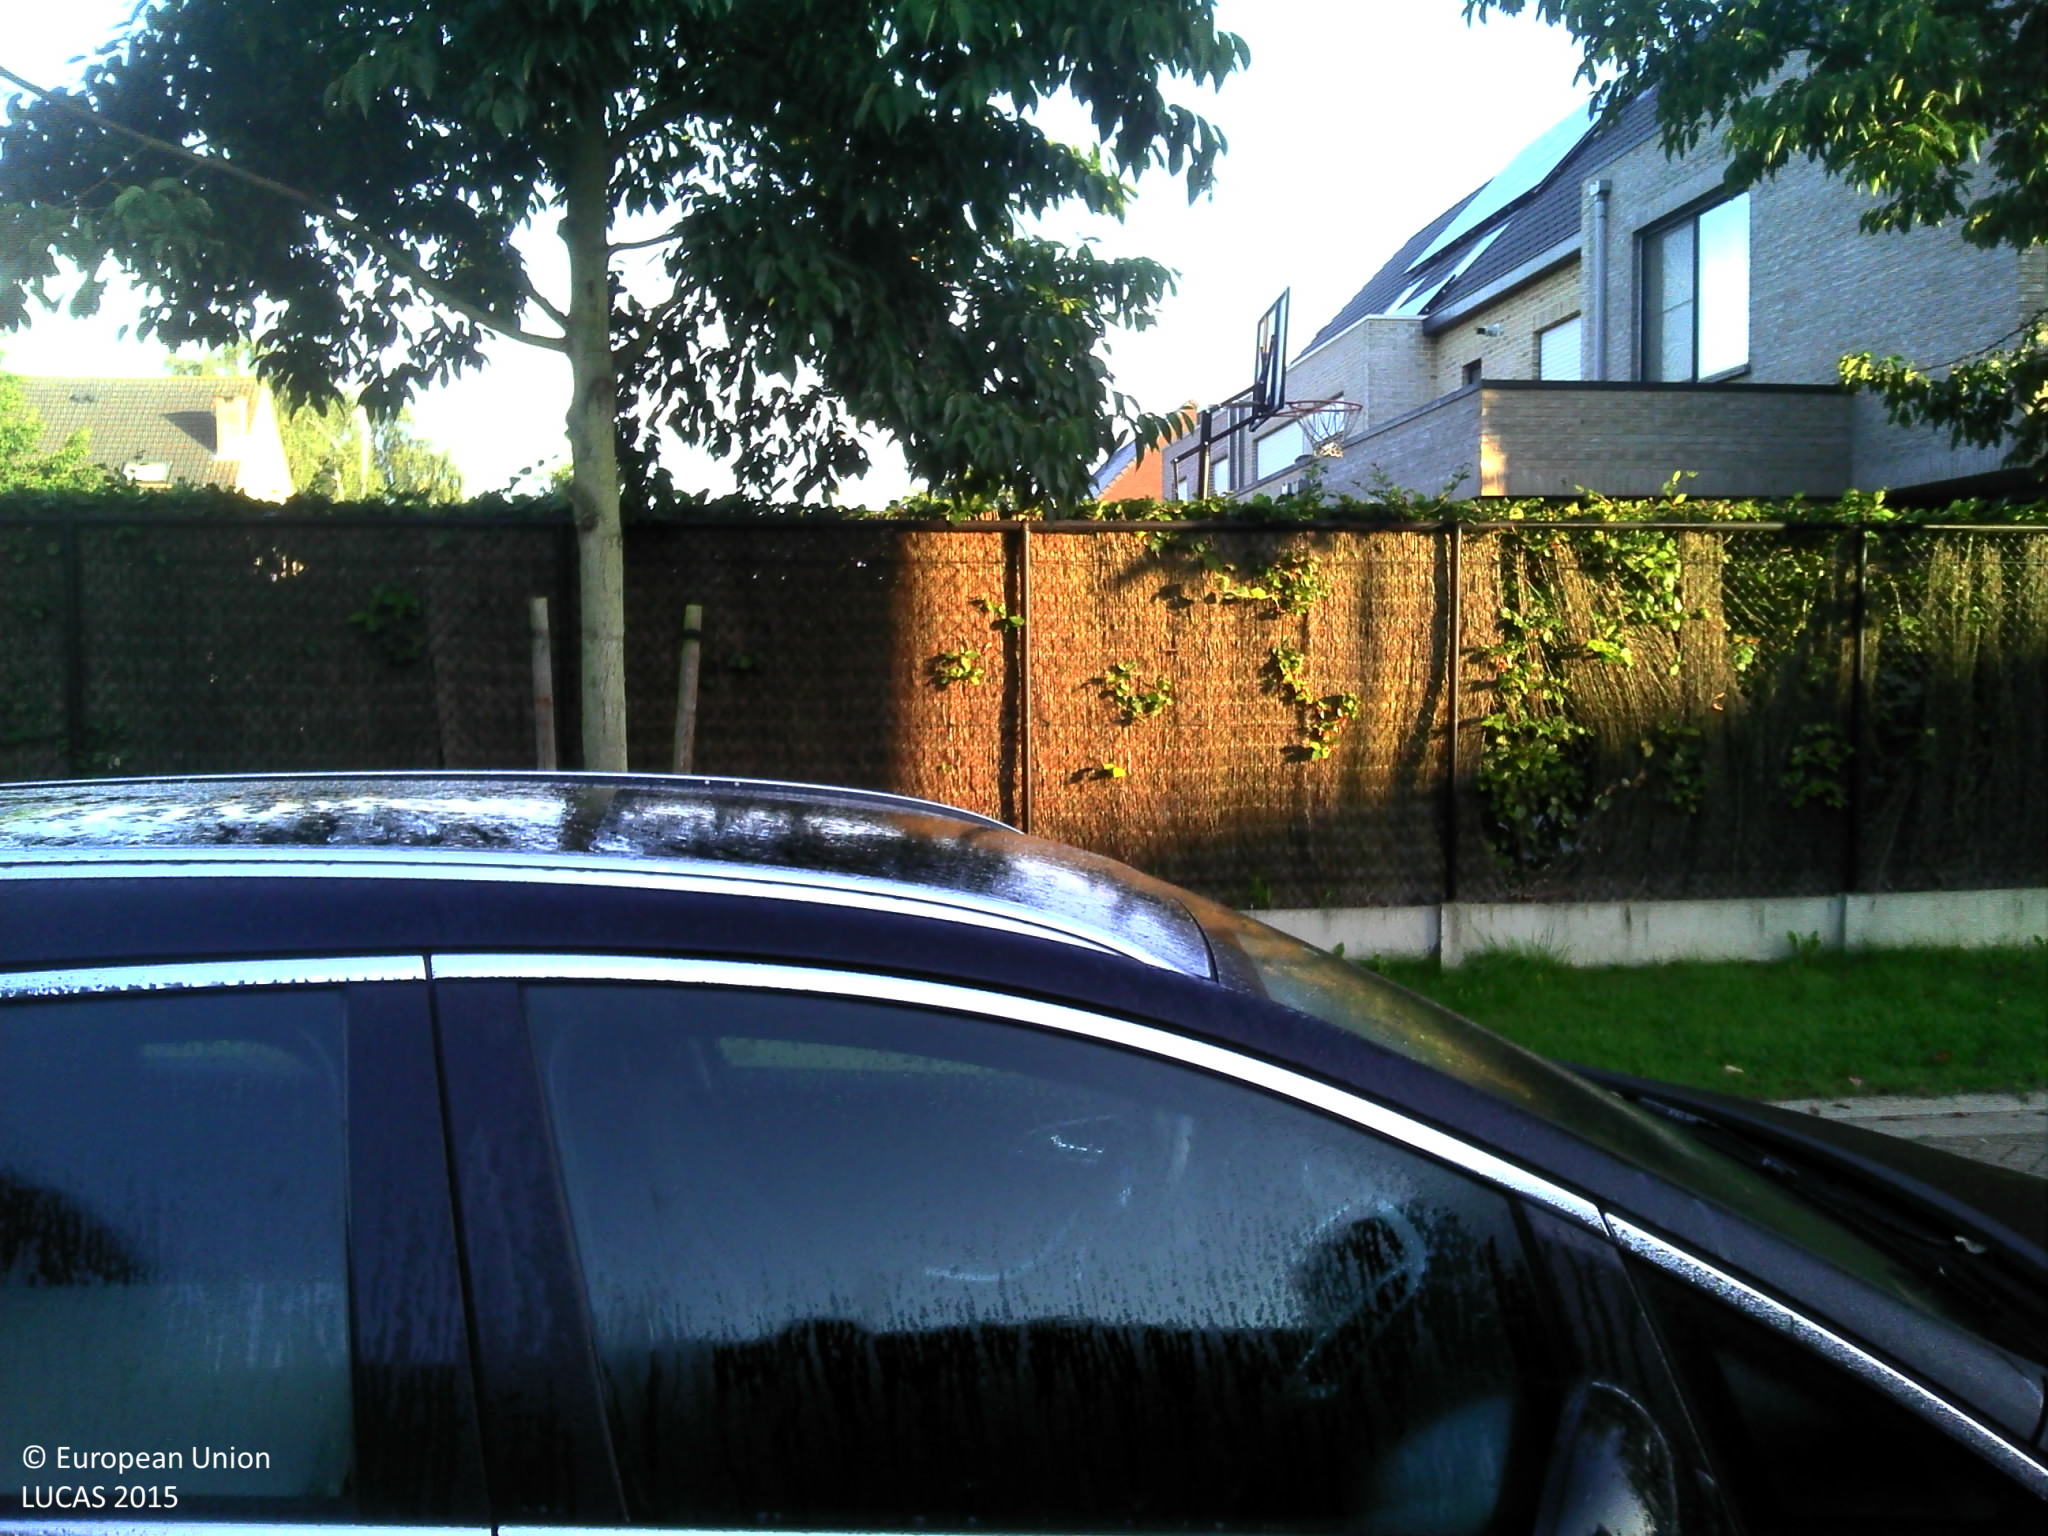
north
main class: Grassland
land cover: Grassland without tree/shrub cover
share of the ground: > 75 %
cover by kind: herbaceous plants 100 %
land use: Residential
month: September
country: BE
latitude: 51.2235
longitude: 4.5117
